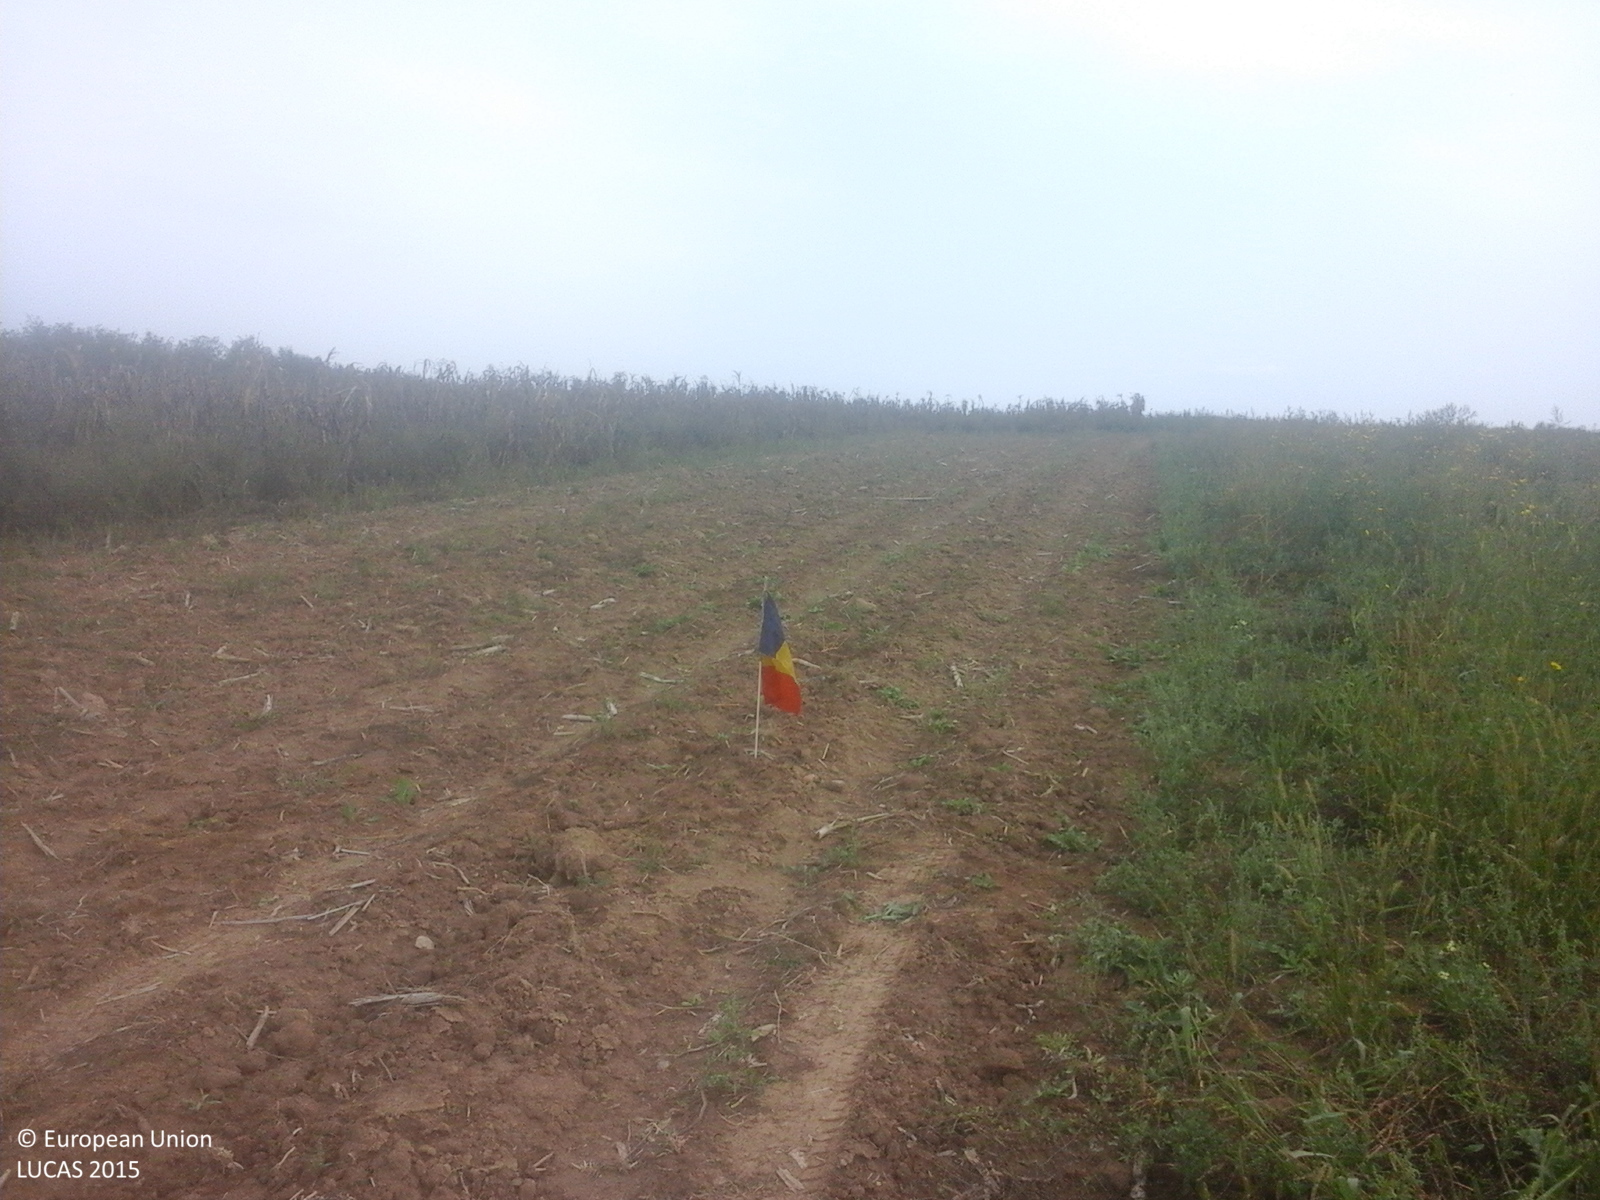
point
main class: Cropland
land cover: Potatoes
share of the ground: < 10 %
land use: Agriculture (excluding fallow land and kitchen gardens)
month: September
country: RO
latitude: 45.8339
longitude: 22.1832
